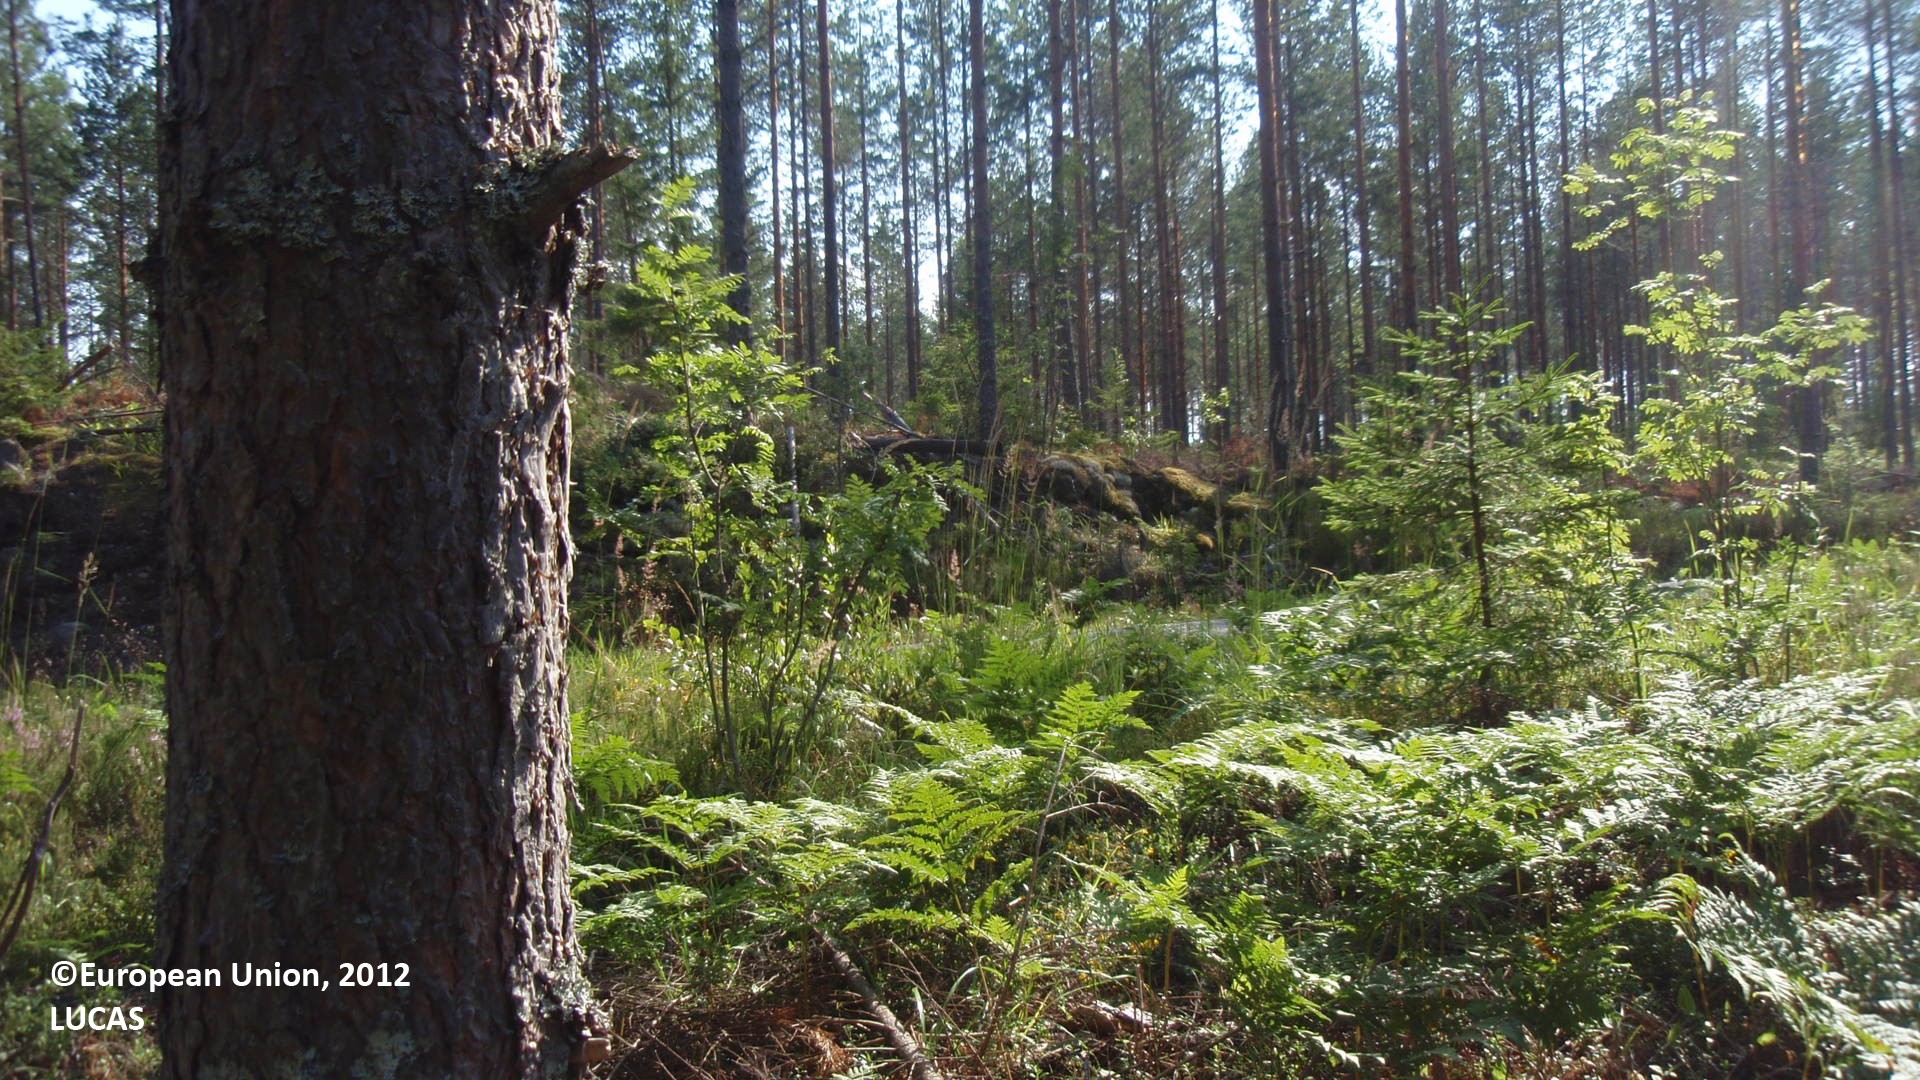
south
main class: Woodland
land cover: Pine dominated coniferous woodland
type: boreal forest
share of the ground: 50 - 75 %
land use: Forestry
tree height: > 5 m
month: July
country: FI
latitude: 61.3889
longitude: 28.3861
